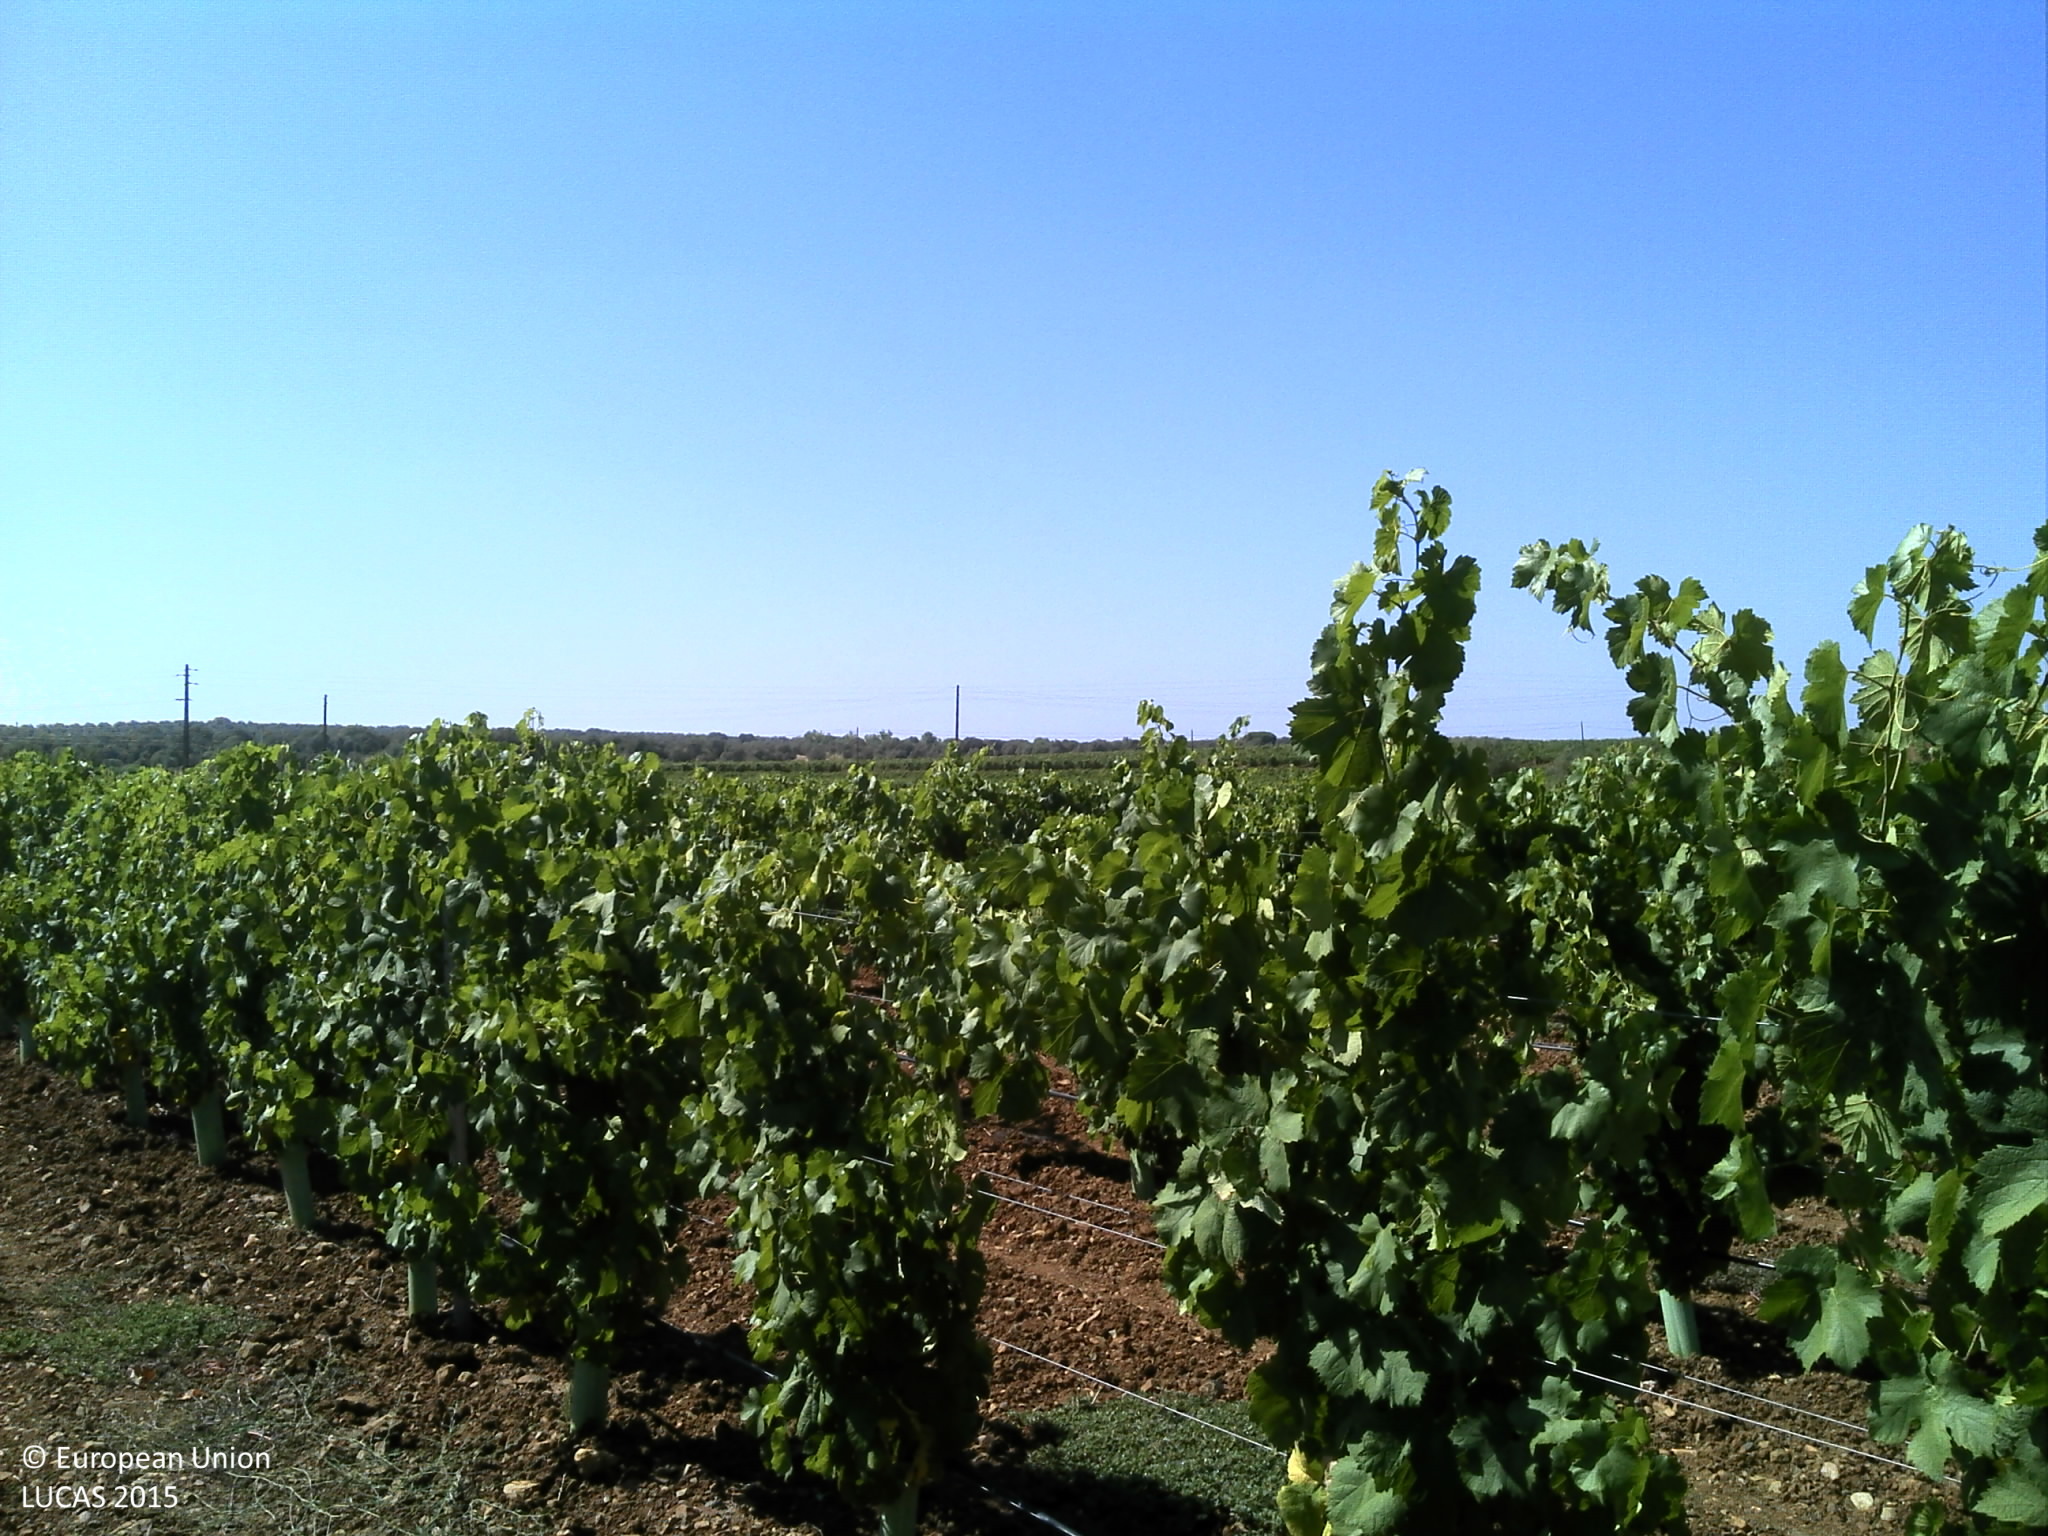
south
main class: Cropland
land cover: Vineyards
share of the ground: 25 - 50 %
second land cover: Other bare soil
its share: > 75 %
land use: Agriculture (excluding fallow land and kitchen gardens)
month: July
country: PT
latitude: 38.4530
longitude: -7.4323
